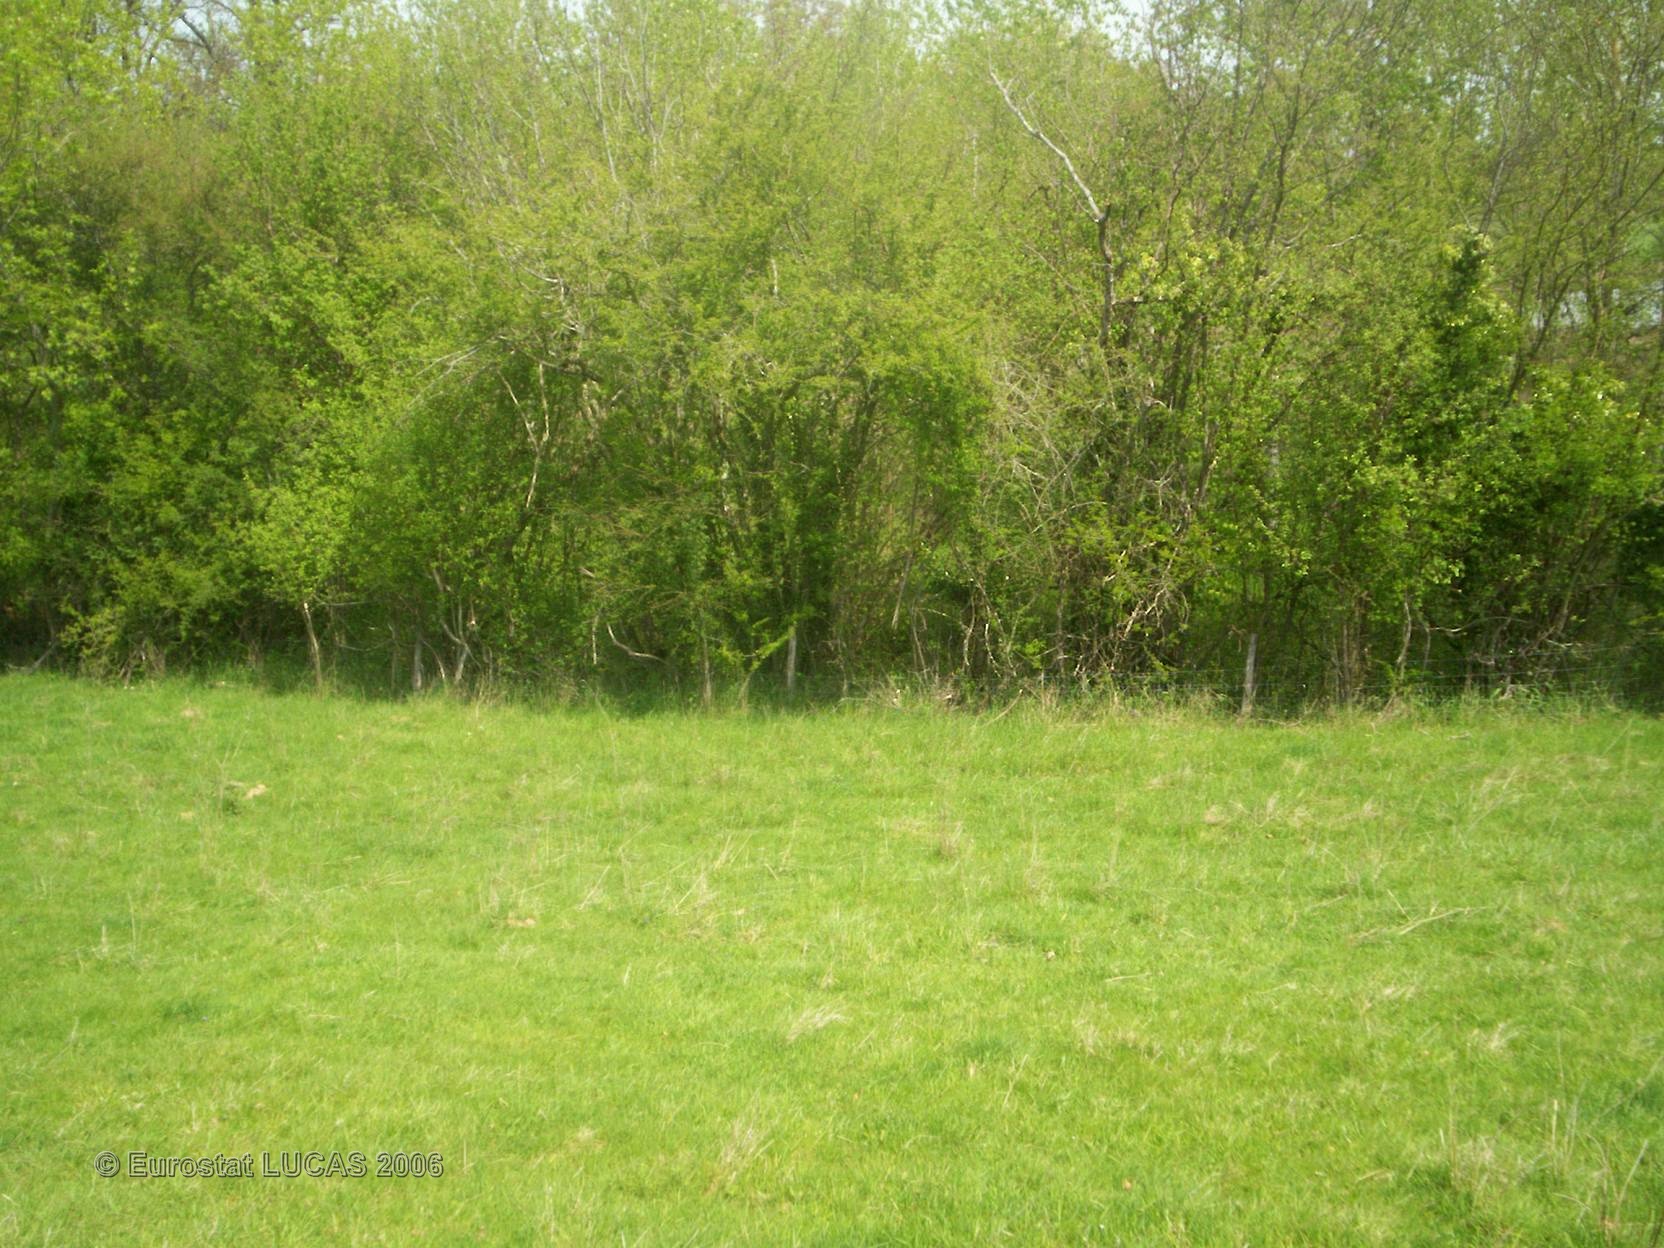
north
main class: Grassland
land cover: Grassland without tree/shrub cover
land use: Agriculture (excluding fallow land and kitchen gardens)
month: May
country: FR
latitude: 46.5064
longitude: 3.0775
